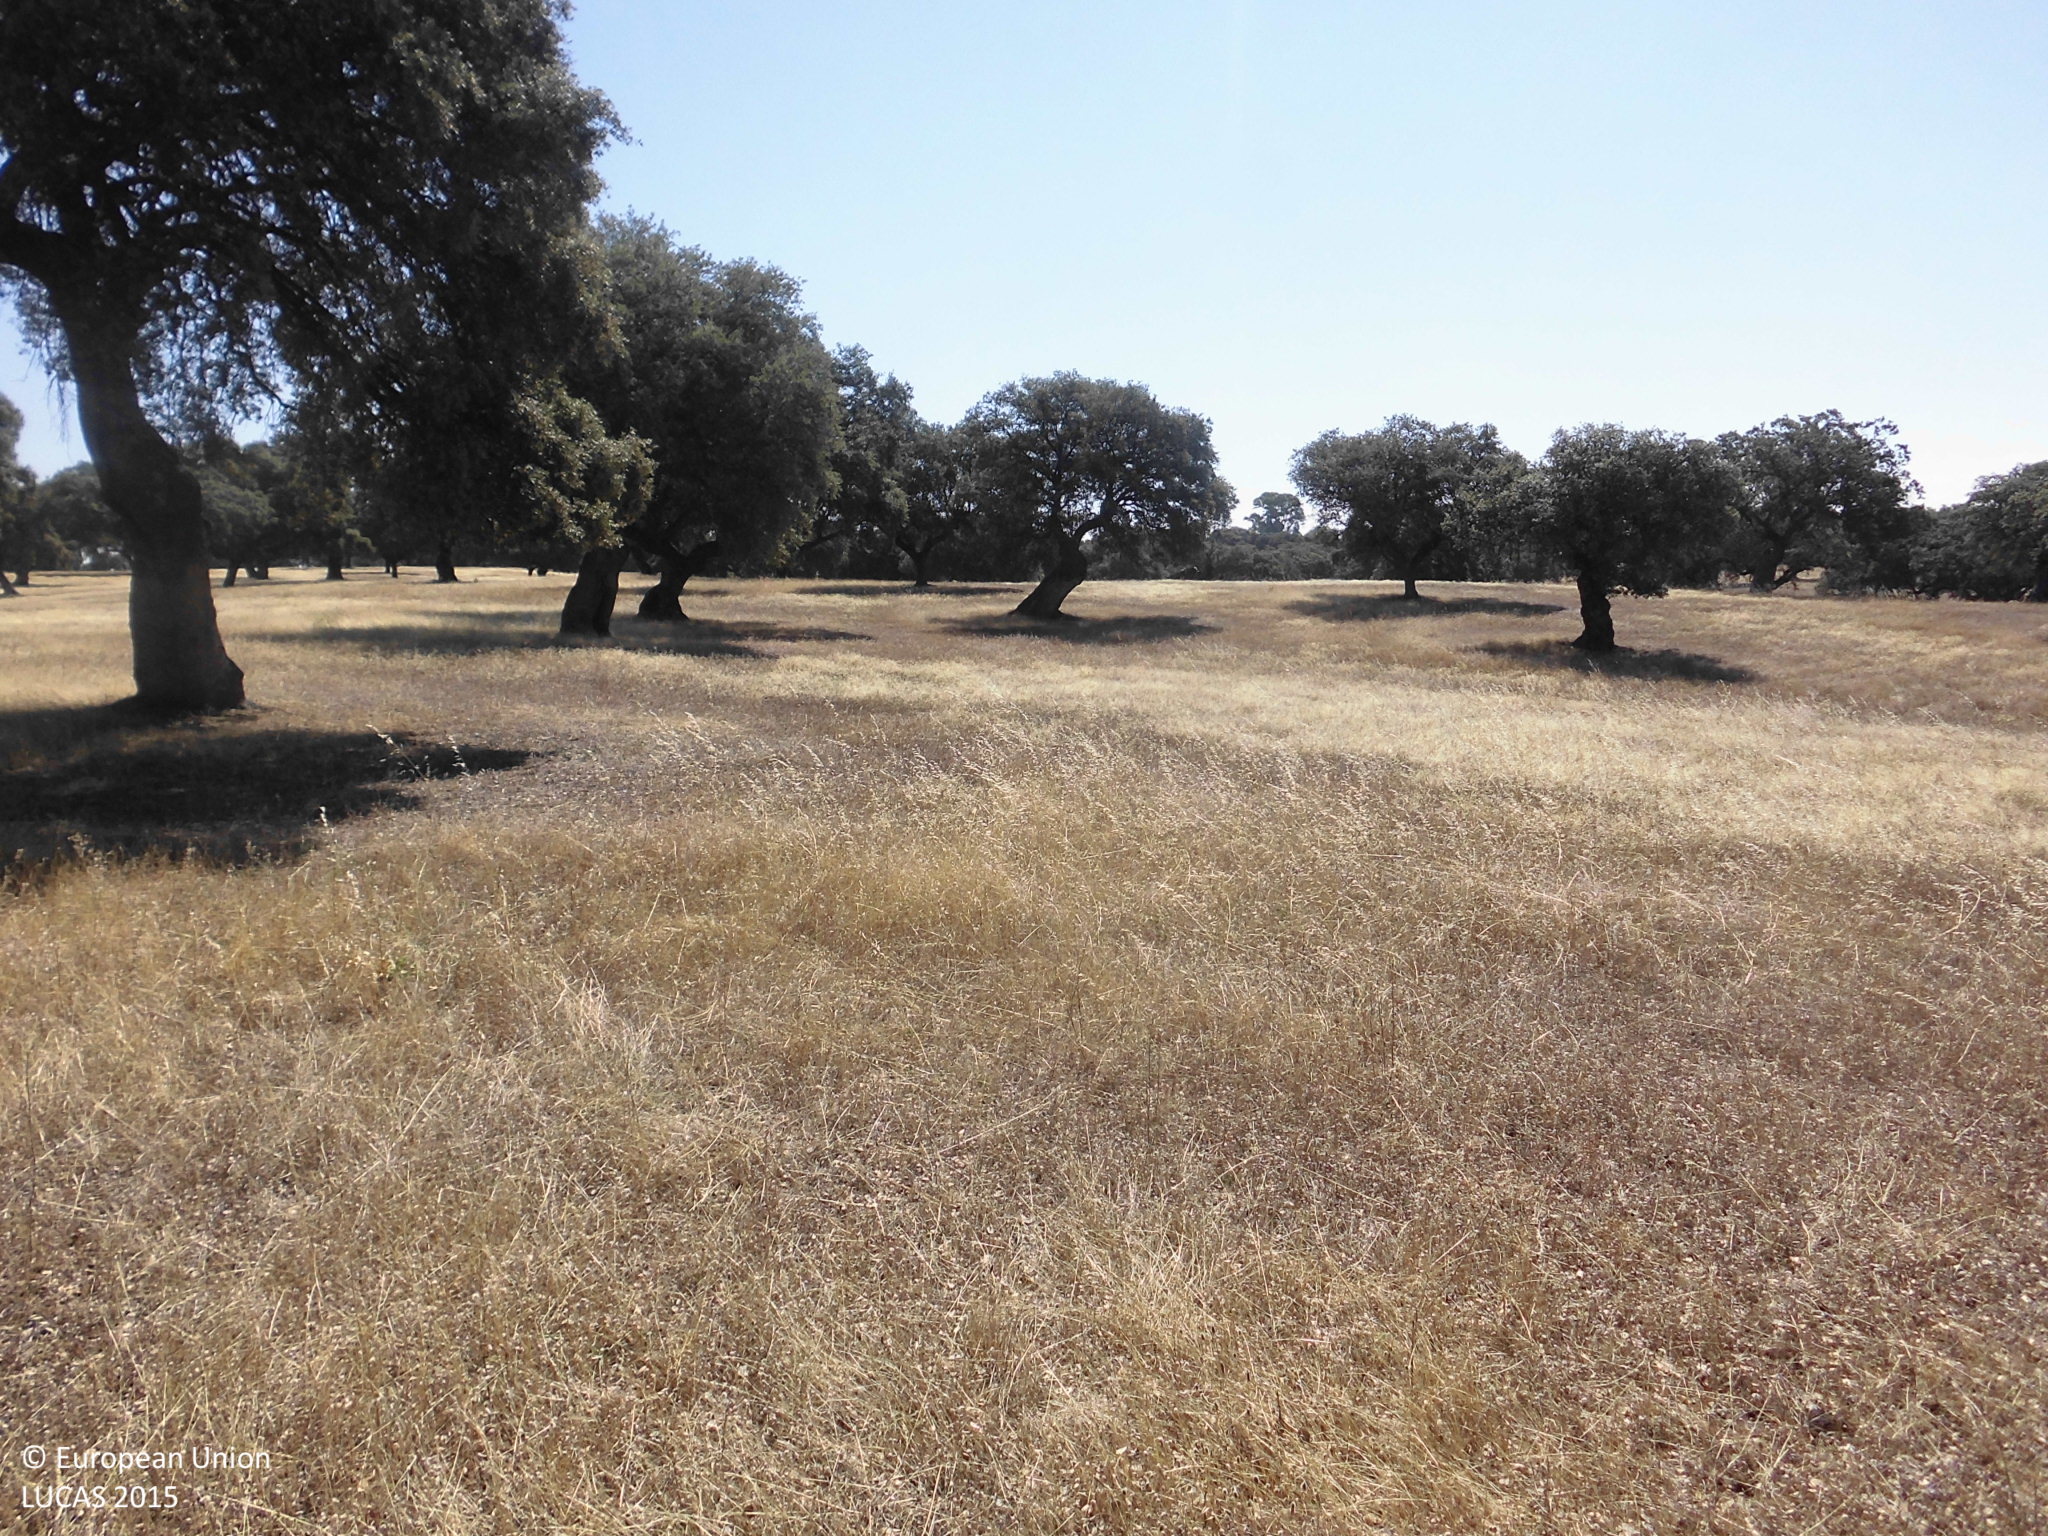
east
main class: Woodland
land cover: Broadleaved woodland
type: broadleaved evergreen forest
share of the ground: 10 - 25 %
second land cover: Grassland without tree/shrub cover
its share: > 75 %
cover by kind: herbaceous plants 75 %, broadleaved forest trees 25 %
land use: Forestry
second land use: Agriculture (excluding fallow land and kitchen gardens)
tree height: > 5 m
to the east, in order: Broadleaved woodland; Grassland without tree/shrub cover; Broadleaved woodland
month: July
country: ES
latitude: 39.8455
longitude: -5.7816
